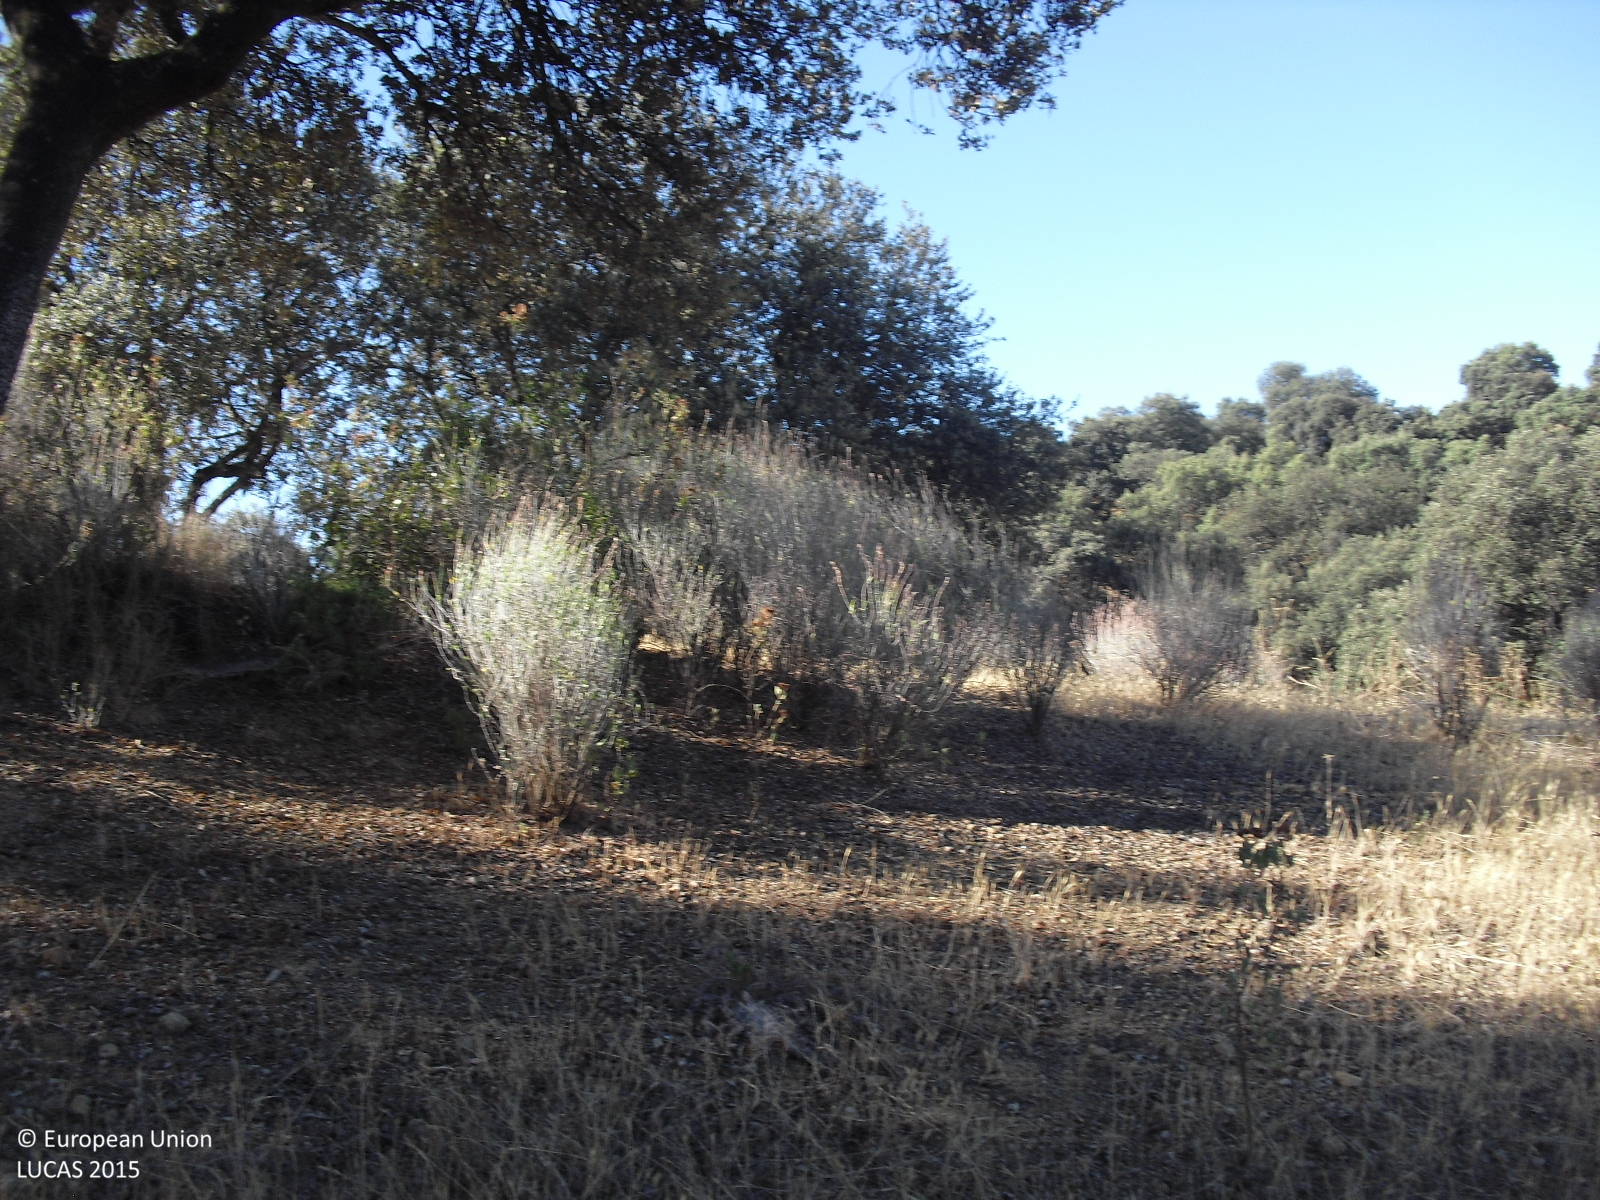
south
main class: Woodland
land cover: Broadleaved woodland
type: broadleaved evergreen forest
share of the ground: 25 - 50 %
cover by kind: herbaceous plants 65 %, broadleaved forest trees 30 %, shrubs 5 %
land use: Forestry
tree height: > 5 m
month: July
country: ES
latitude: 37.0236
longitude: -5.3731
